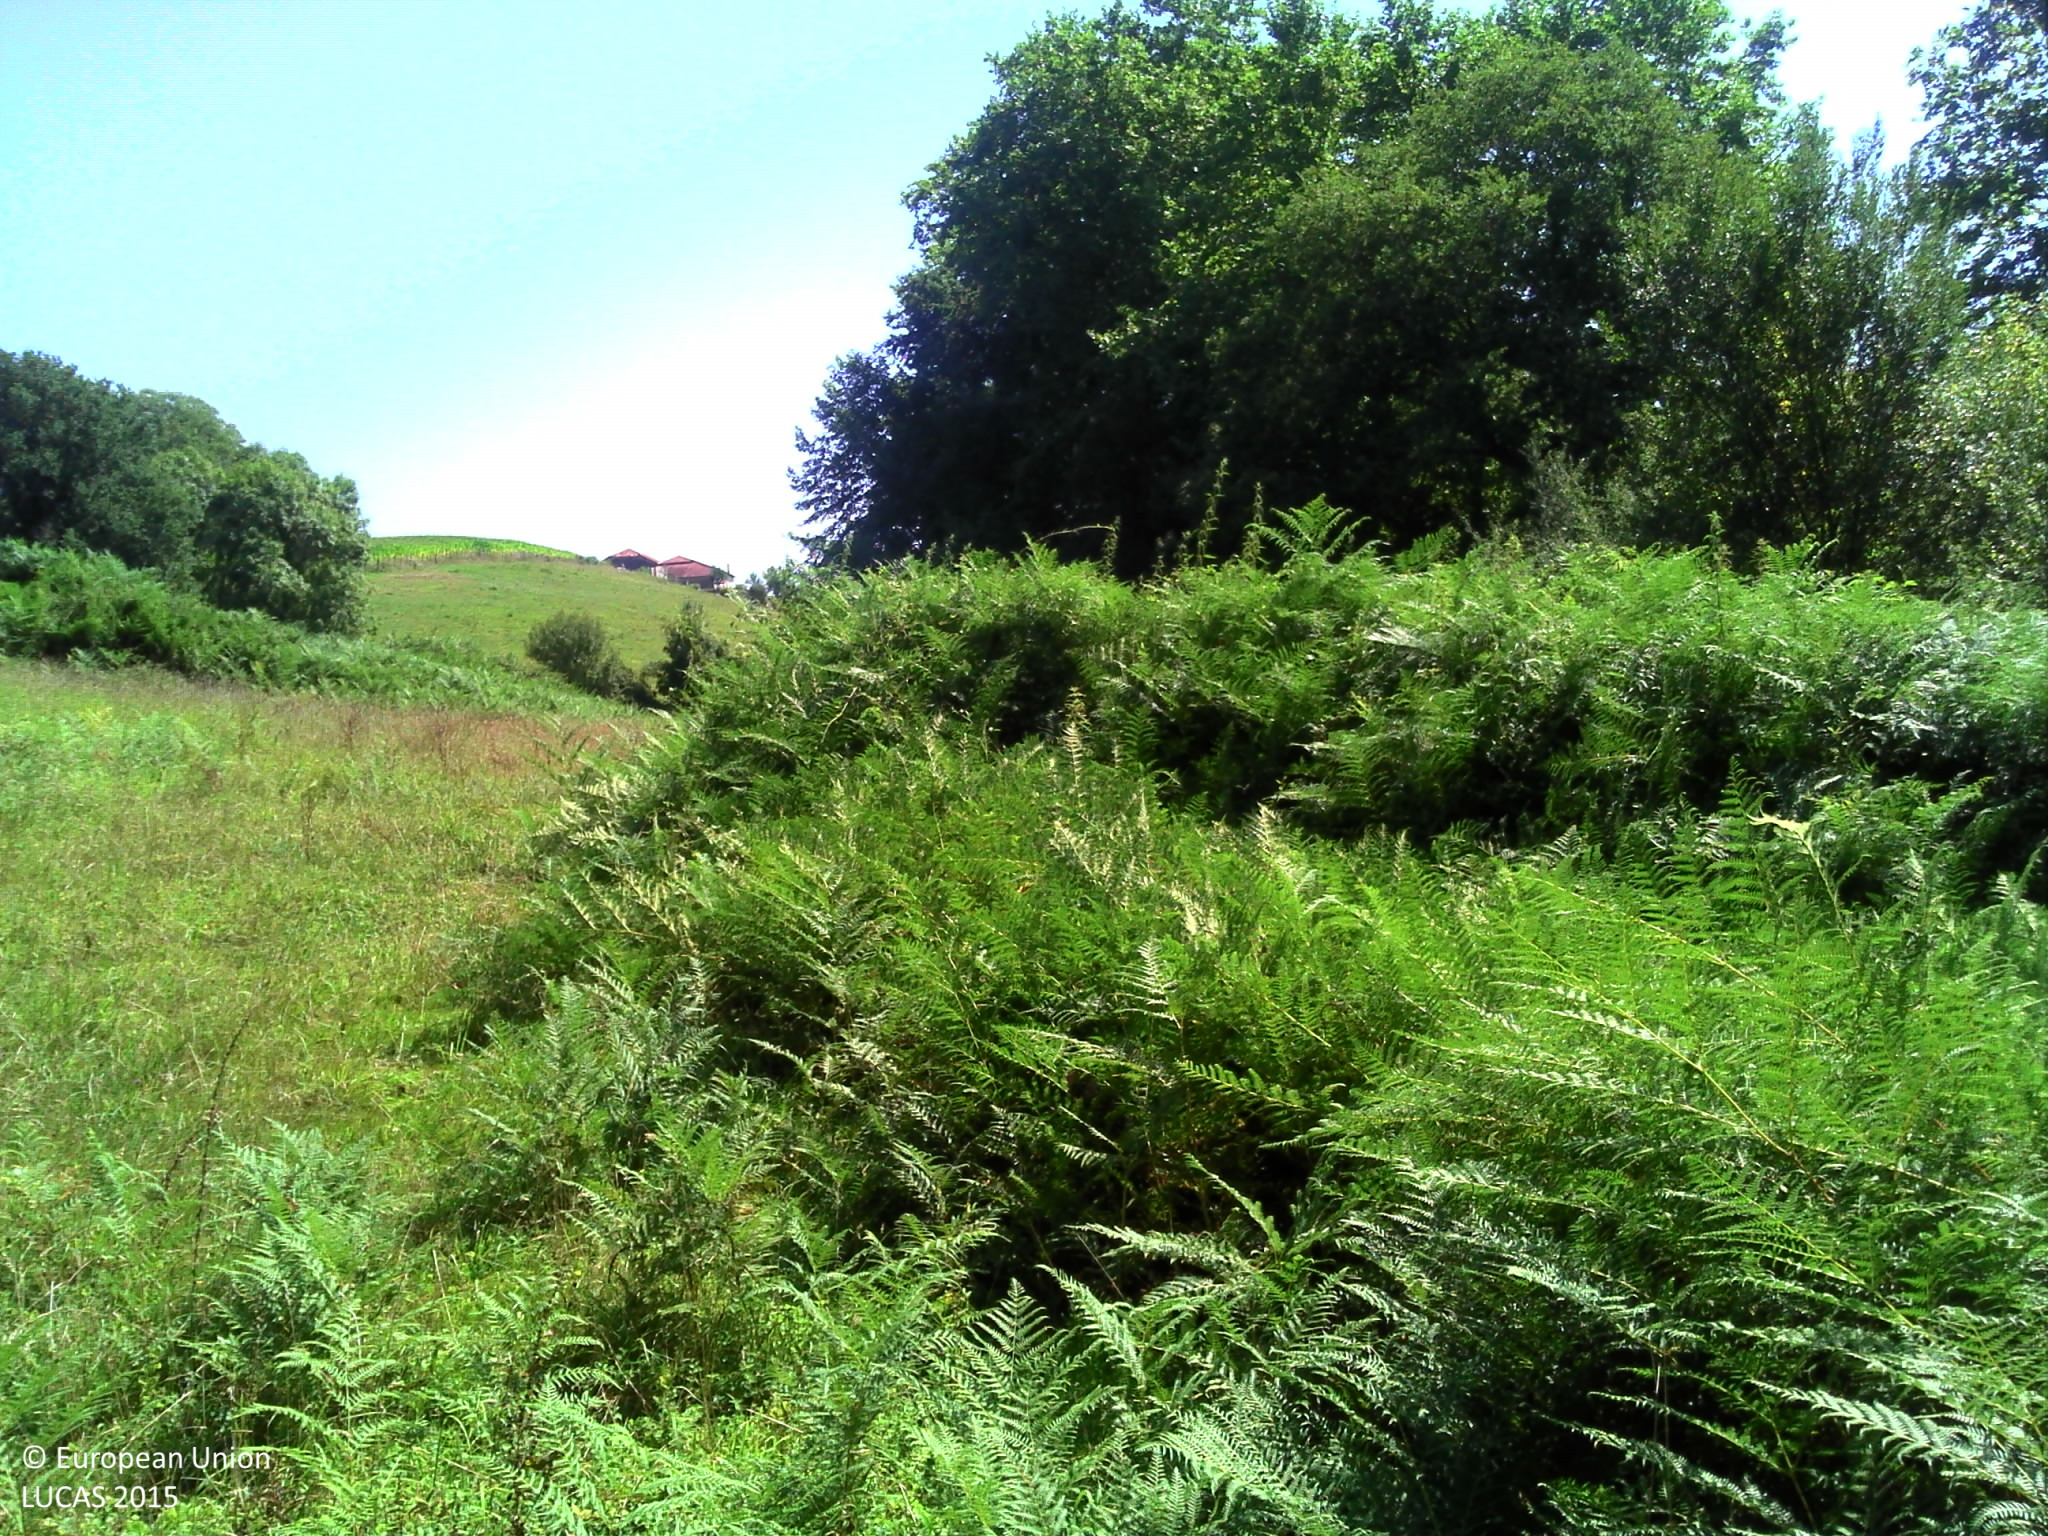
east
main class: Grassland
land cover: Spontaneously vegetated surfaces
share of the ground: > 75 %
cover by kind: herbaceous plants 95 %, shrubs 5 %
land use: Agriculture (excluding fallow land and kitchen gardens)
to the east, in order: Spontaneously vegetated surfaces; Grassland without tree/shrub cover; Fences; Ditches and canals; Broadleaved woodland; Fences; Grassland without tree/shrub cover; Broadleaved woodland; Grassland without tree/shrub cover; Fences; Ditches and canals; Maize
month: August
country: FR
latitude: 43.4058
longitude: -1.1152
